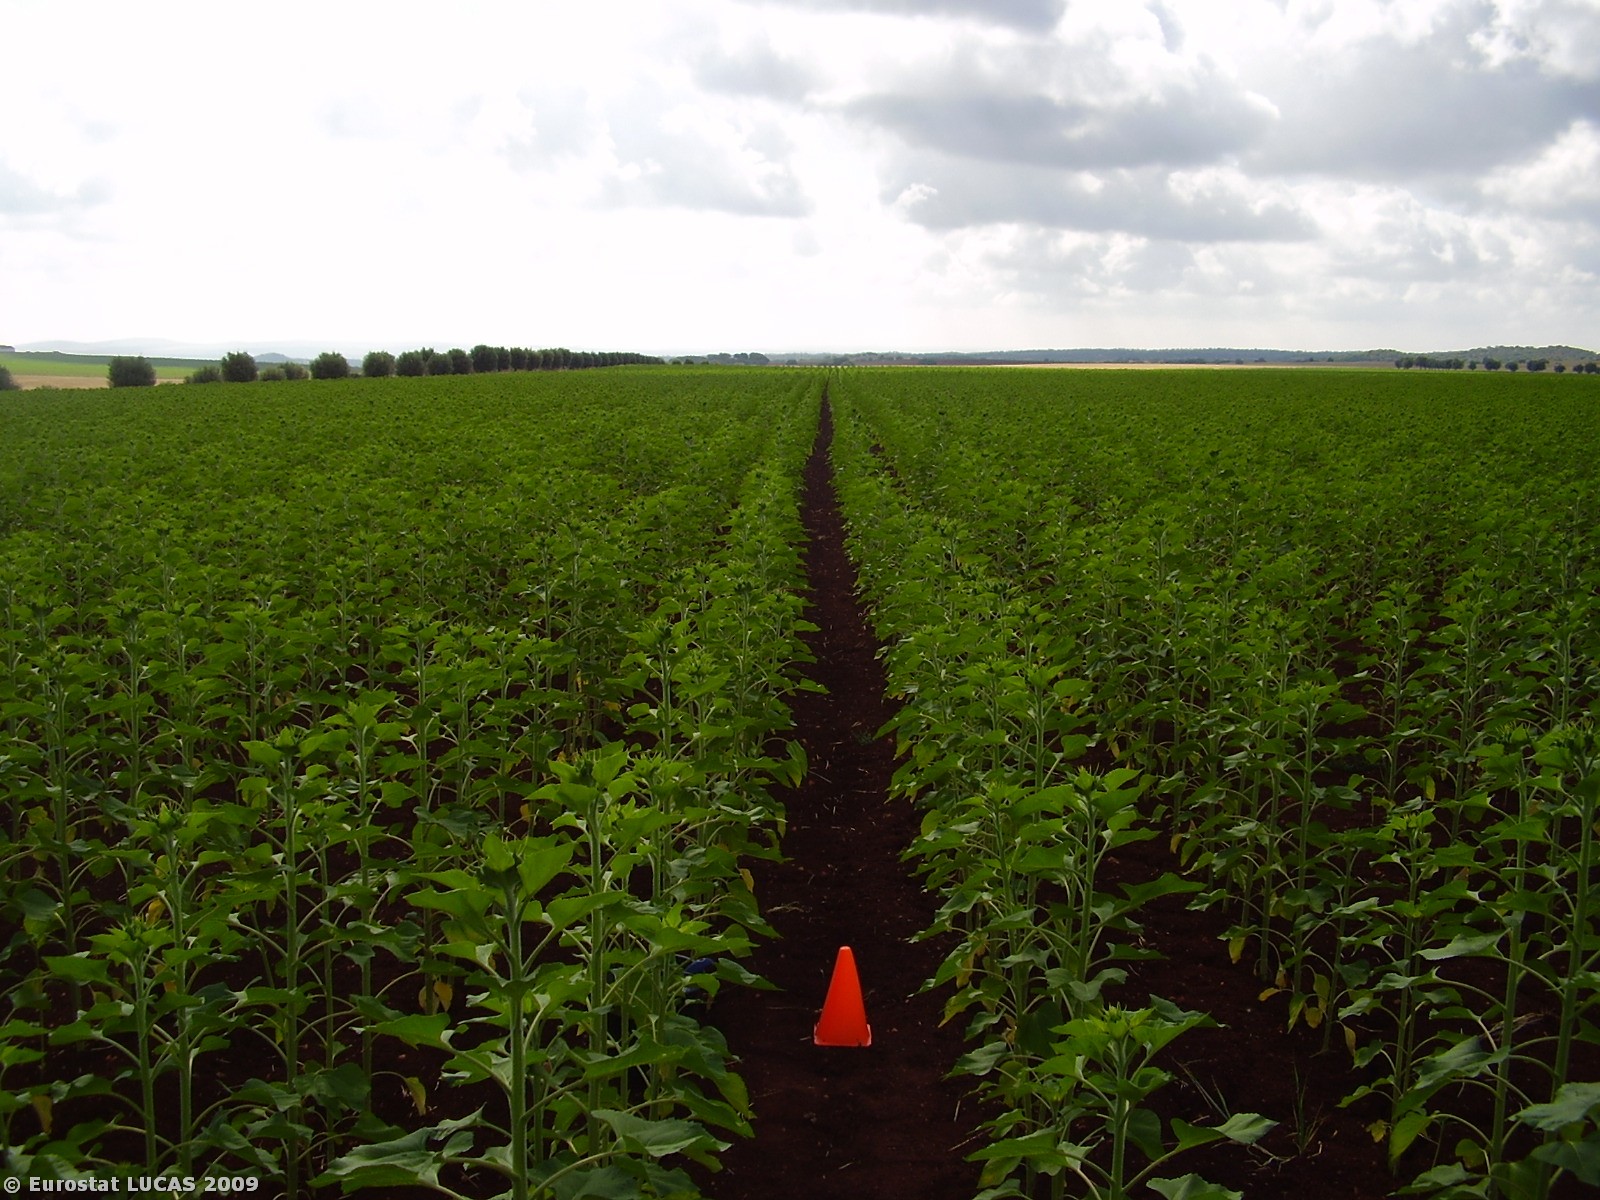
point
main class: Cropland
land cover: Sunflower
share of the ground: 50 - 75 %
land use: Agriculture (excluding fallow land and kitchen gardens)
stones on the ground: < 10 %
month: May
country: PT
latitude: 37.9298
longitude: -7.7605
